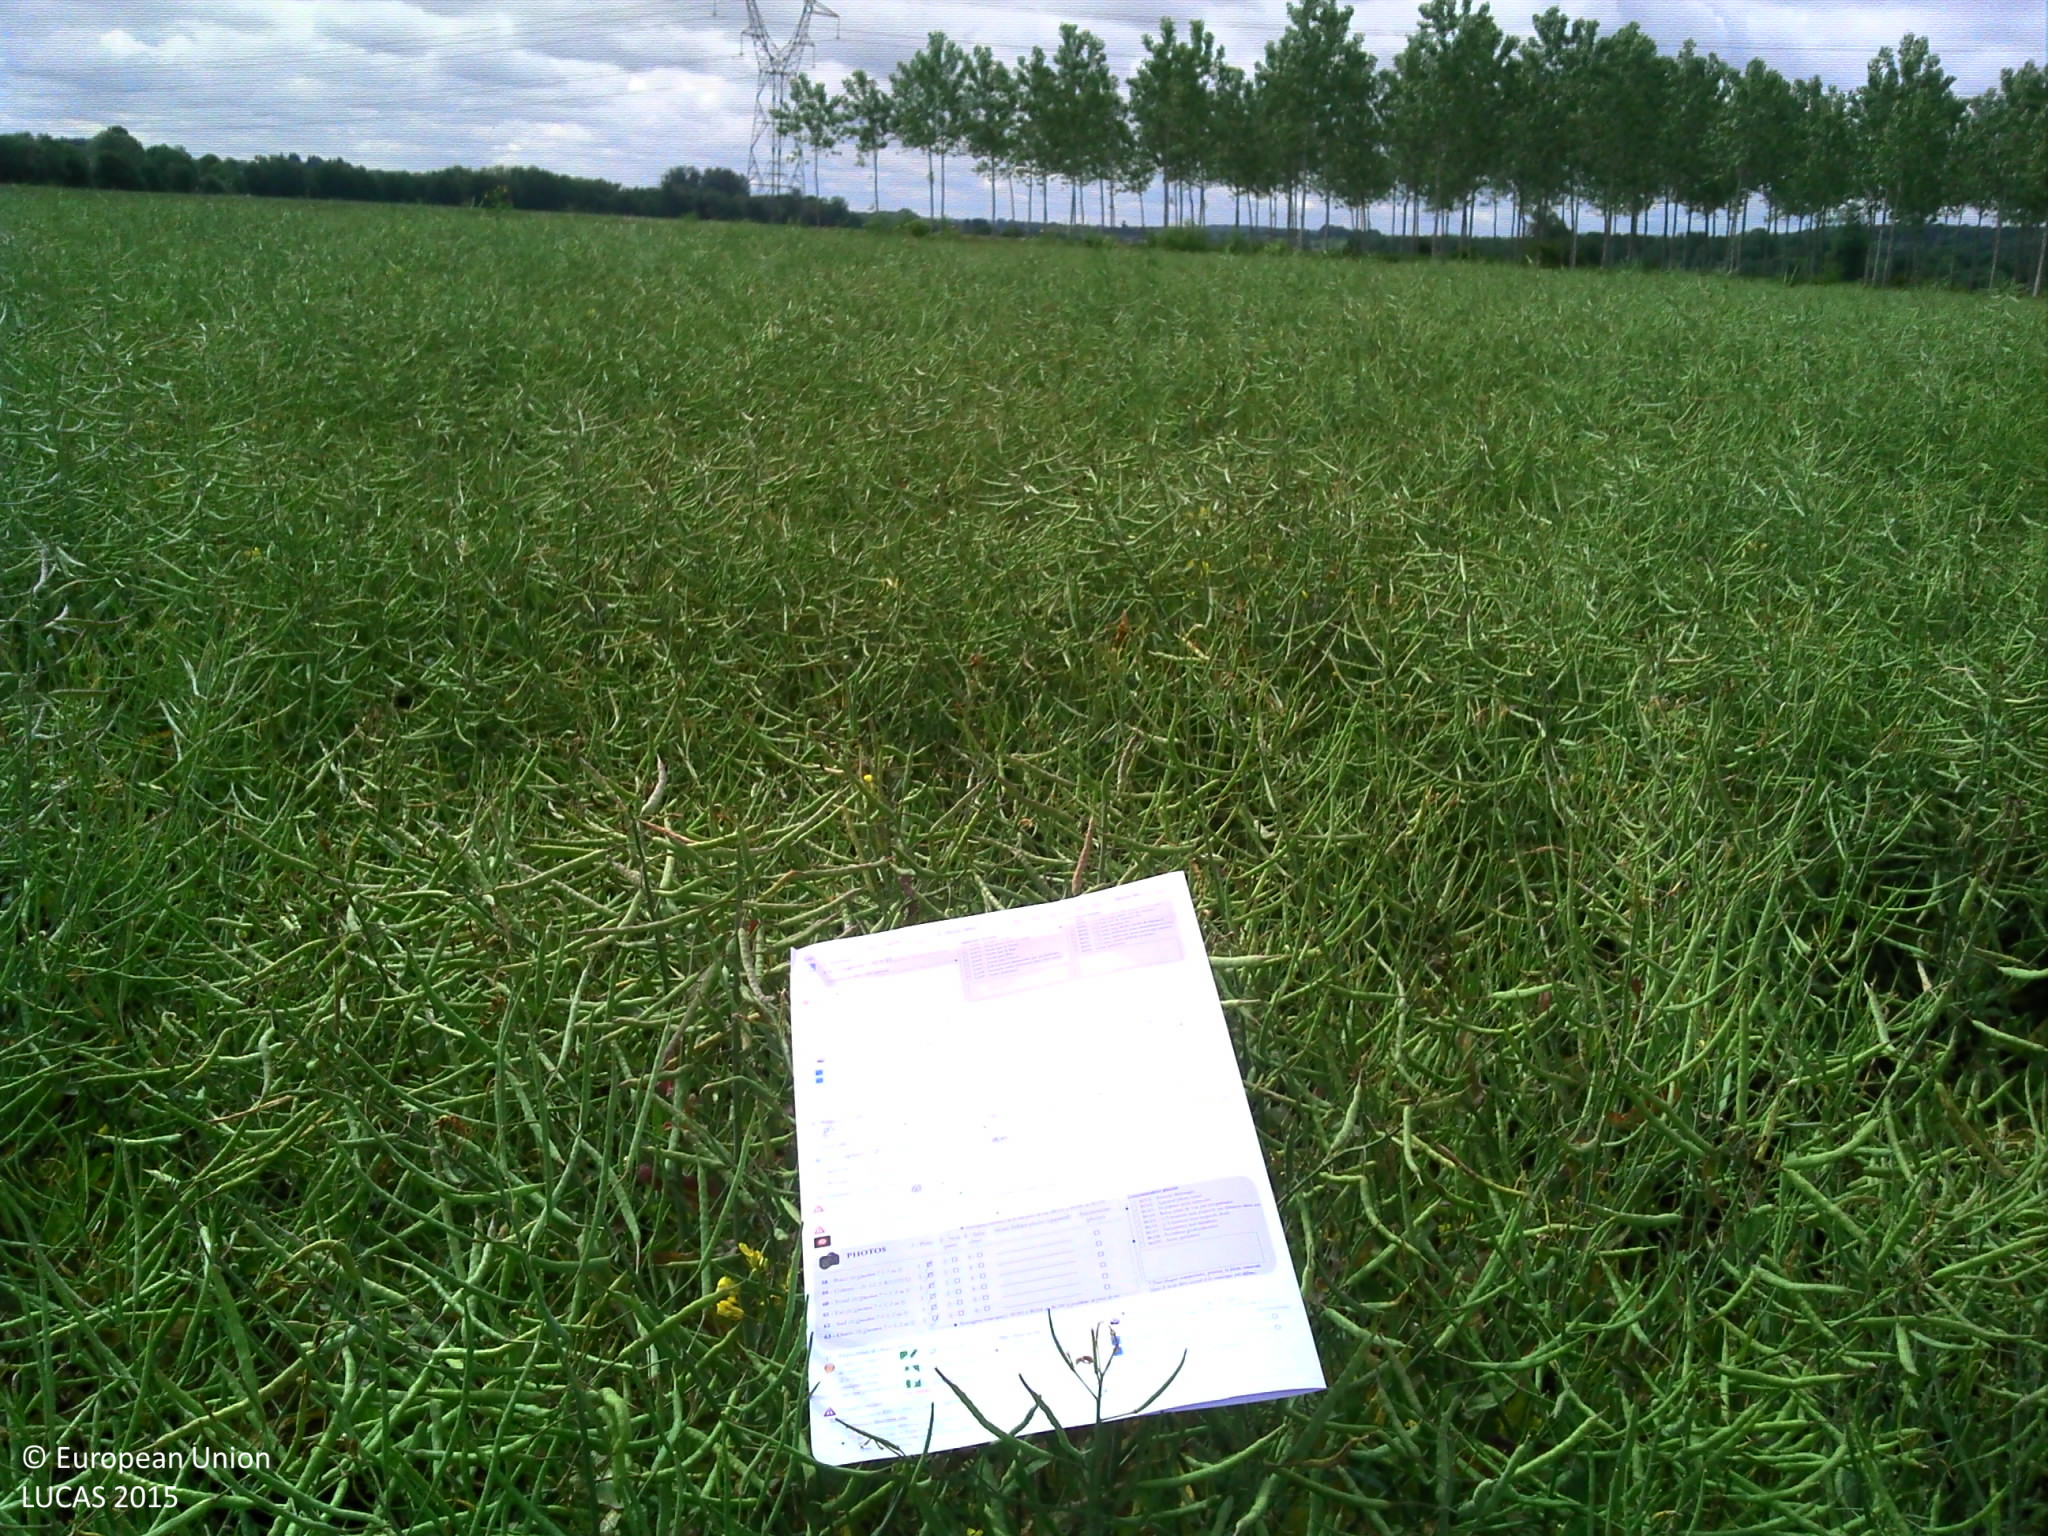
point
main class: Cropland
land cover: Rape and turnip rape
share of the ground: > 75 %
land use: Agriculture (excluding fallow land and kitchen gardens)
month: June
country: FR
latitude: 48.5212
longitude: 4.9210
